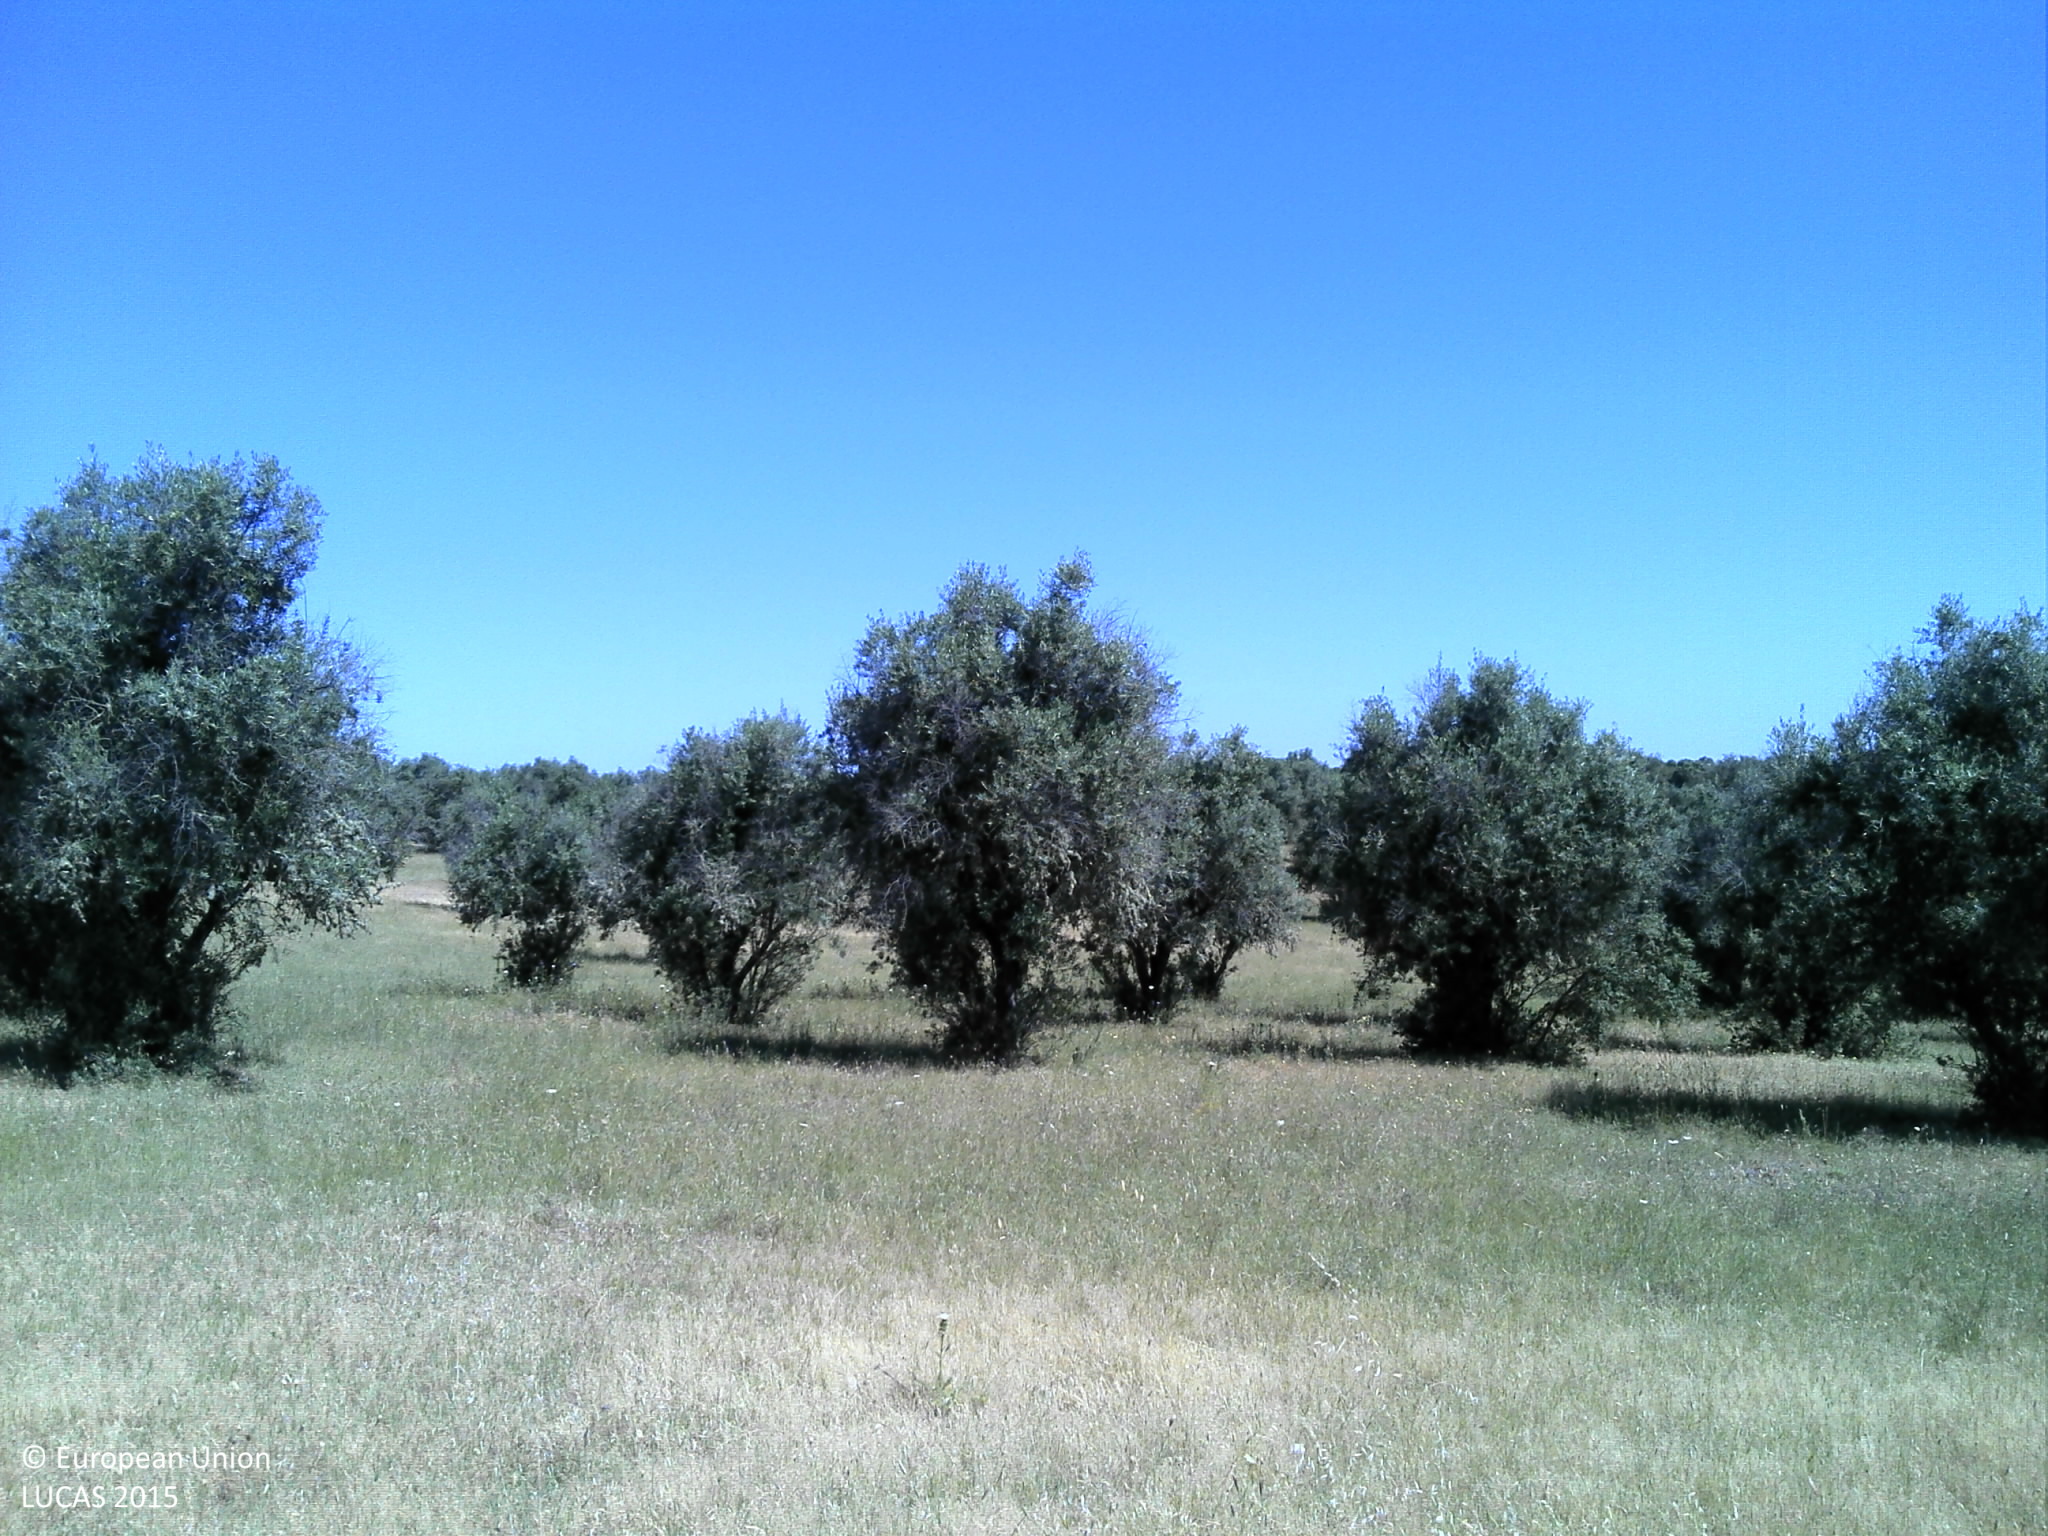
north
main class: Grassland
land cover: Grassland without tree/shrub cover
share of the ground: 50 - 75 %
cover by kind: herbaceous plants 75 %, unconsolidated bare surface 25 %
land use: Agriculture (excluding fallow land and kitchen gardens)
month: May
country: PT
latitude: 38.8578
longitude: -8.1311
